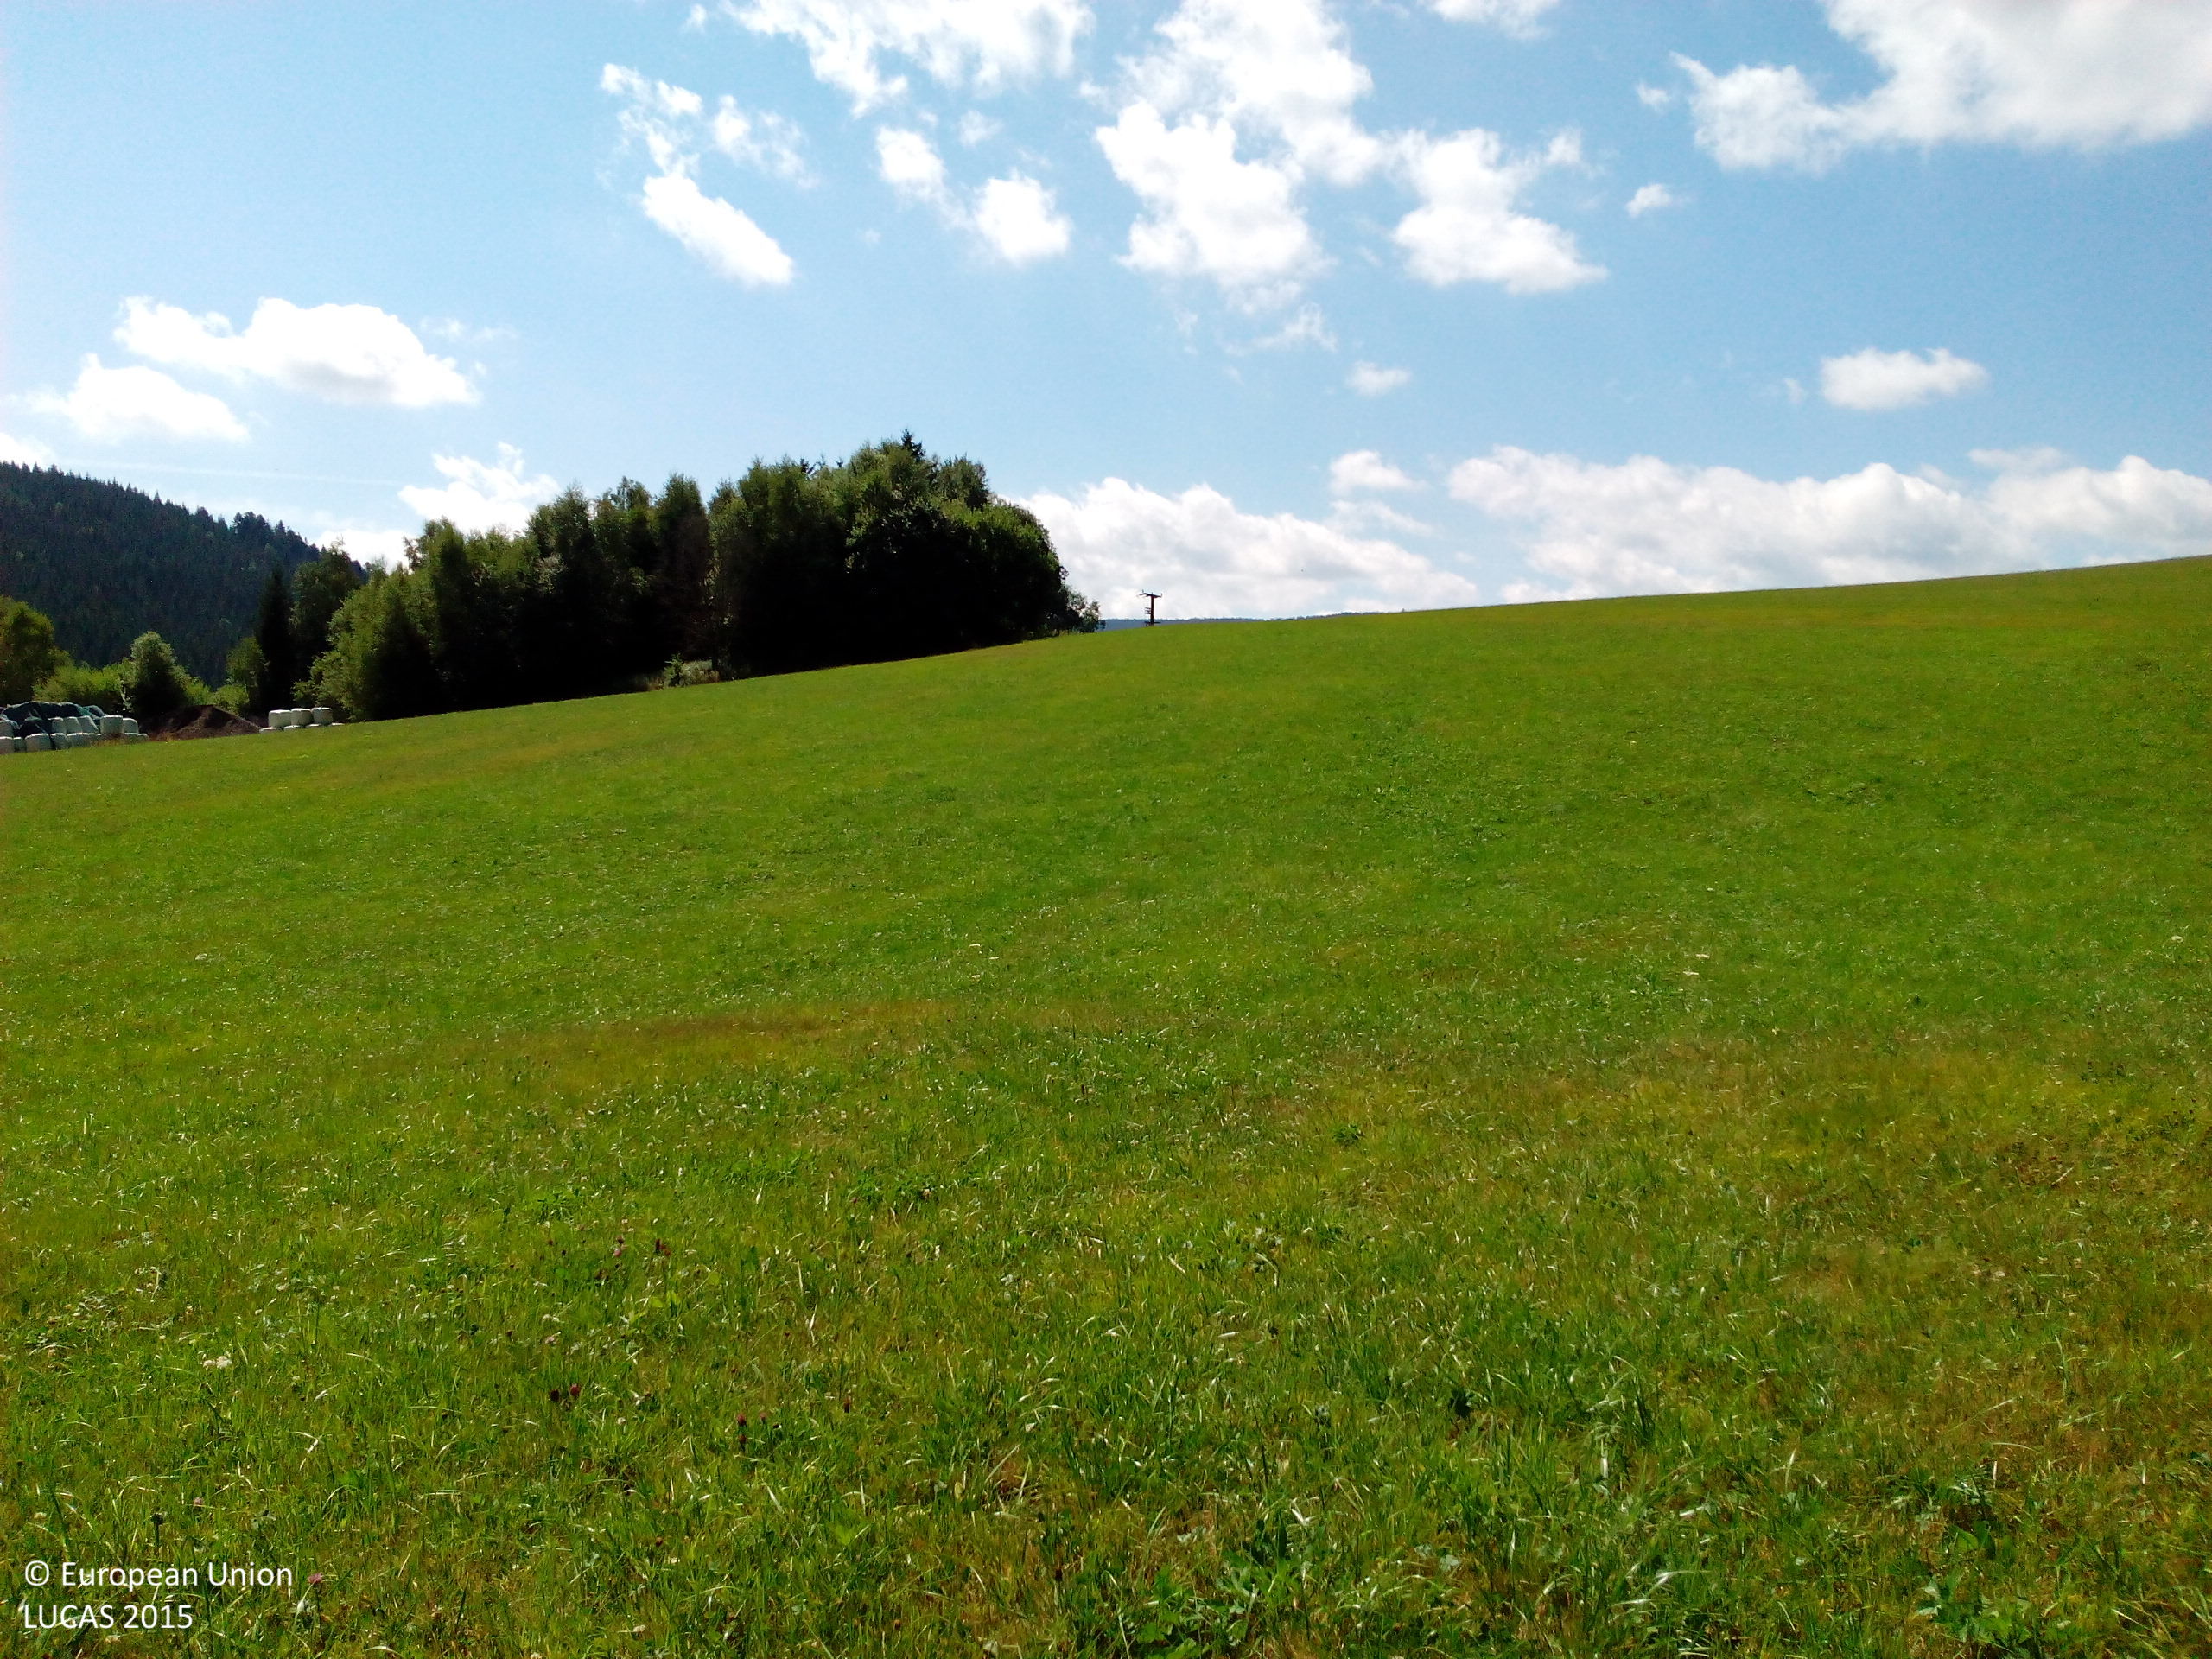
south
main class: Grassland
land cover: Grassland without tree/shrub cover
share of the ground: > 75 %
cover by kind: herbaceous plants 100 %
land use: Agriculture (excluding fallow land and kitchen gardens)
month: August
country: DE
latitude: 47.9387
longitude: 8.1939
